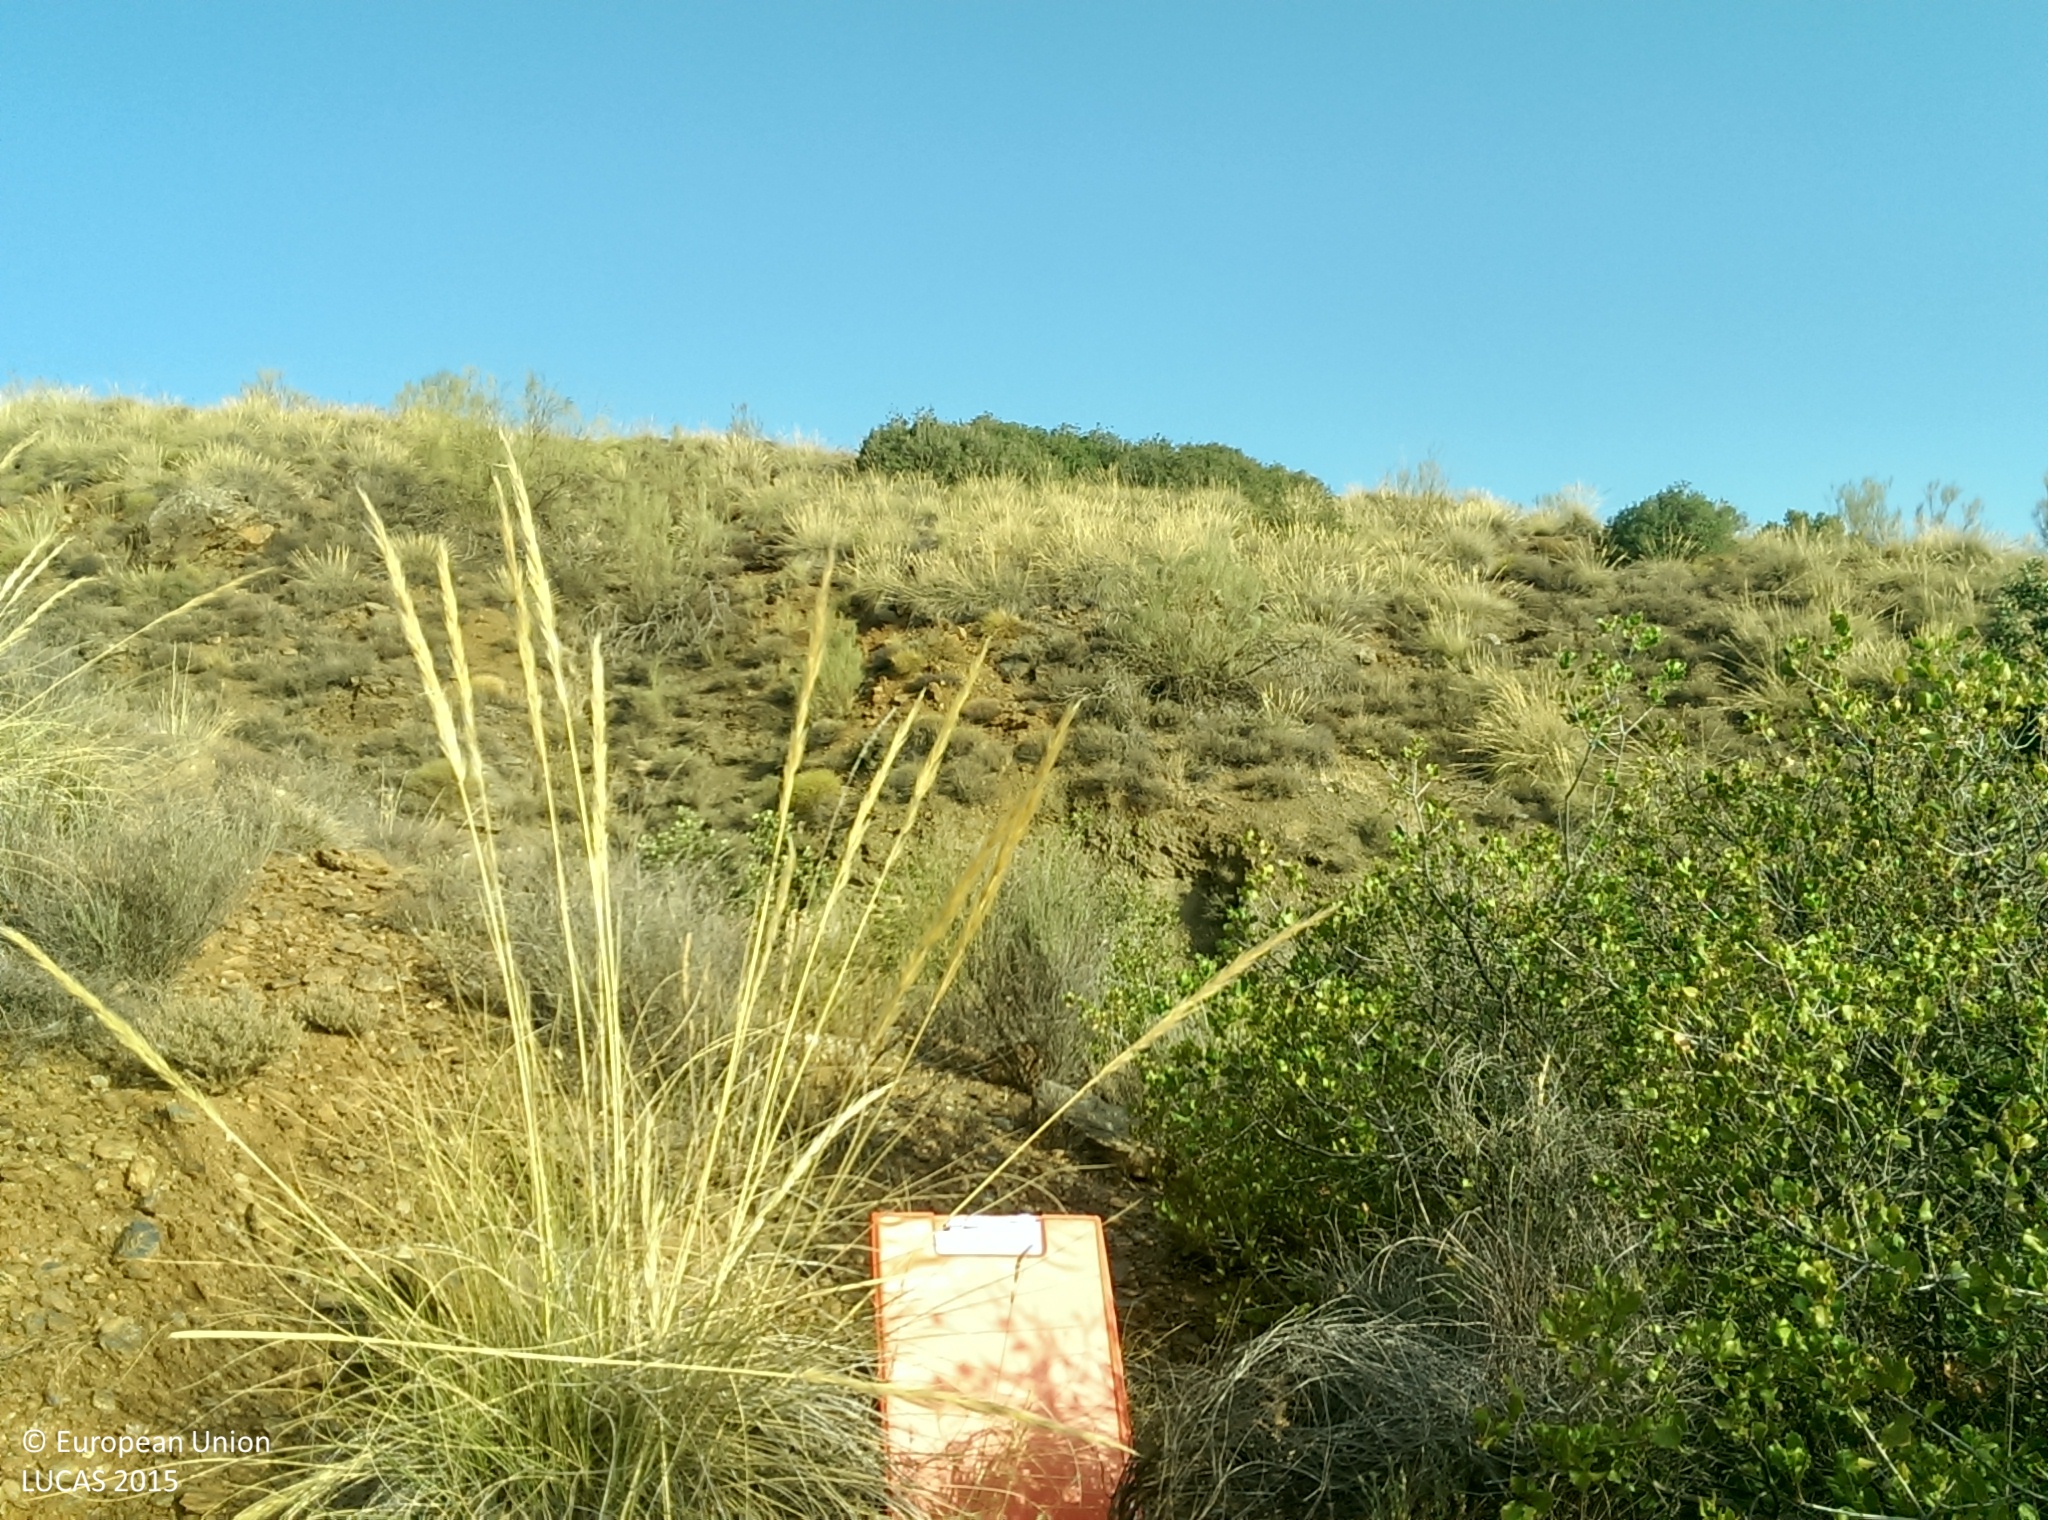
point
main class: Shrubland
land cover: Shrubland without tree cover
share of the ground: 10 - 25 %
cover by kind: herbaceous plants 40 %, unconsolidated bare surface 30 %, shrubs 20 %, consolidated bare surface 10 %
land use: Forestry
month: July
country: ES
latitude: 37.1468
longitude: -2.8511
